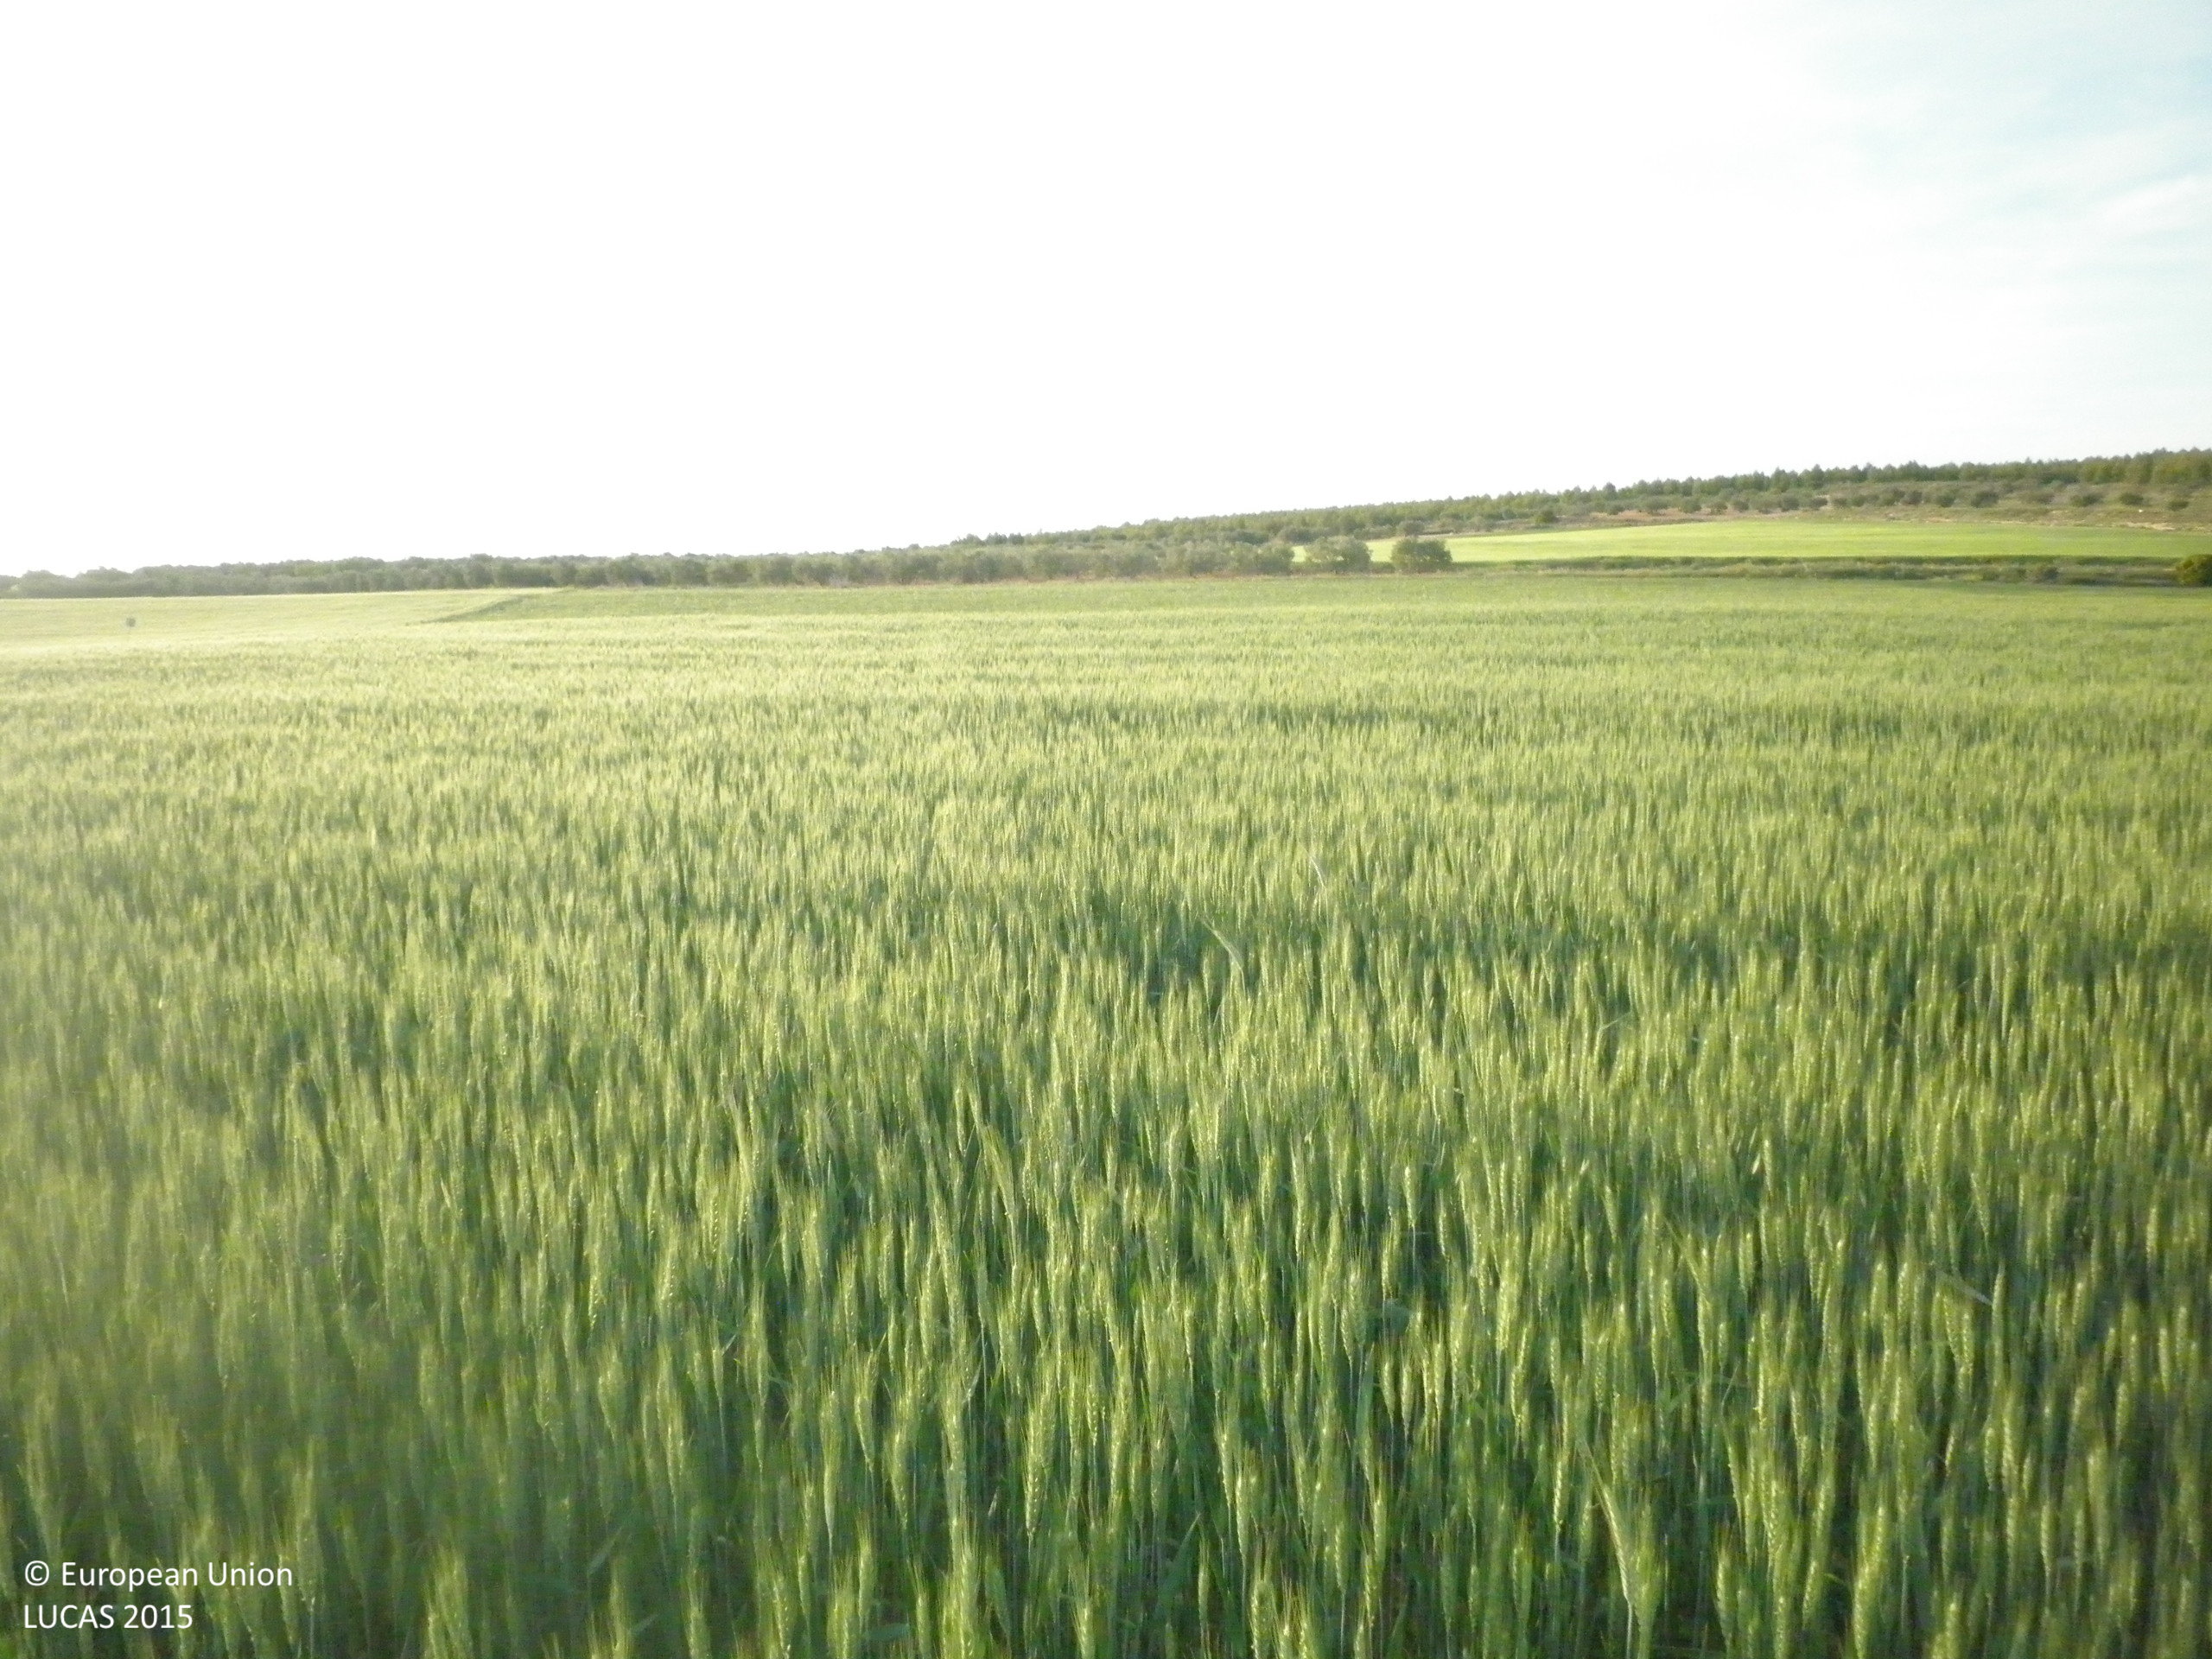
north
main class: Cropland
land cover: Durum wheat
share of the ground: > 75 %
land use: Agriculture (excluding fallow land and kitchen gardens)
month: May
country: ES
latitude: 39.6033
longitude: -2.6980
